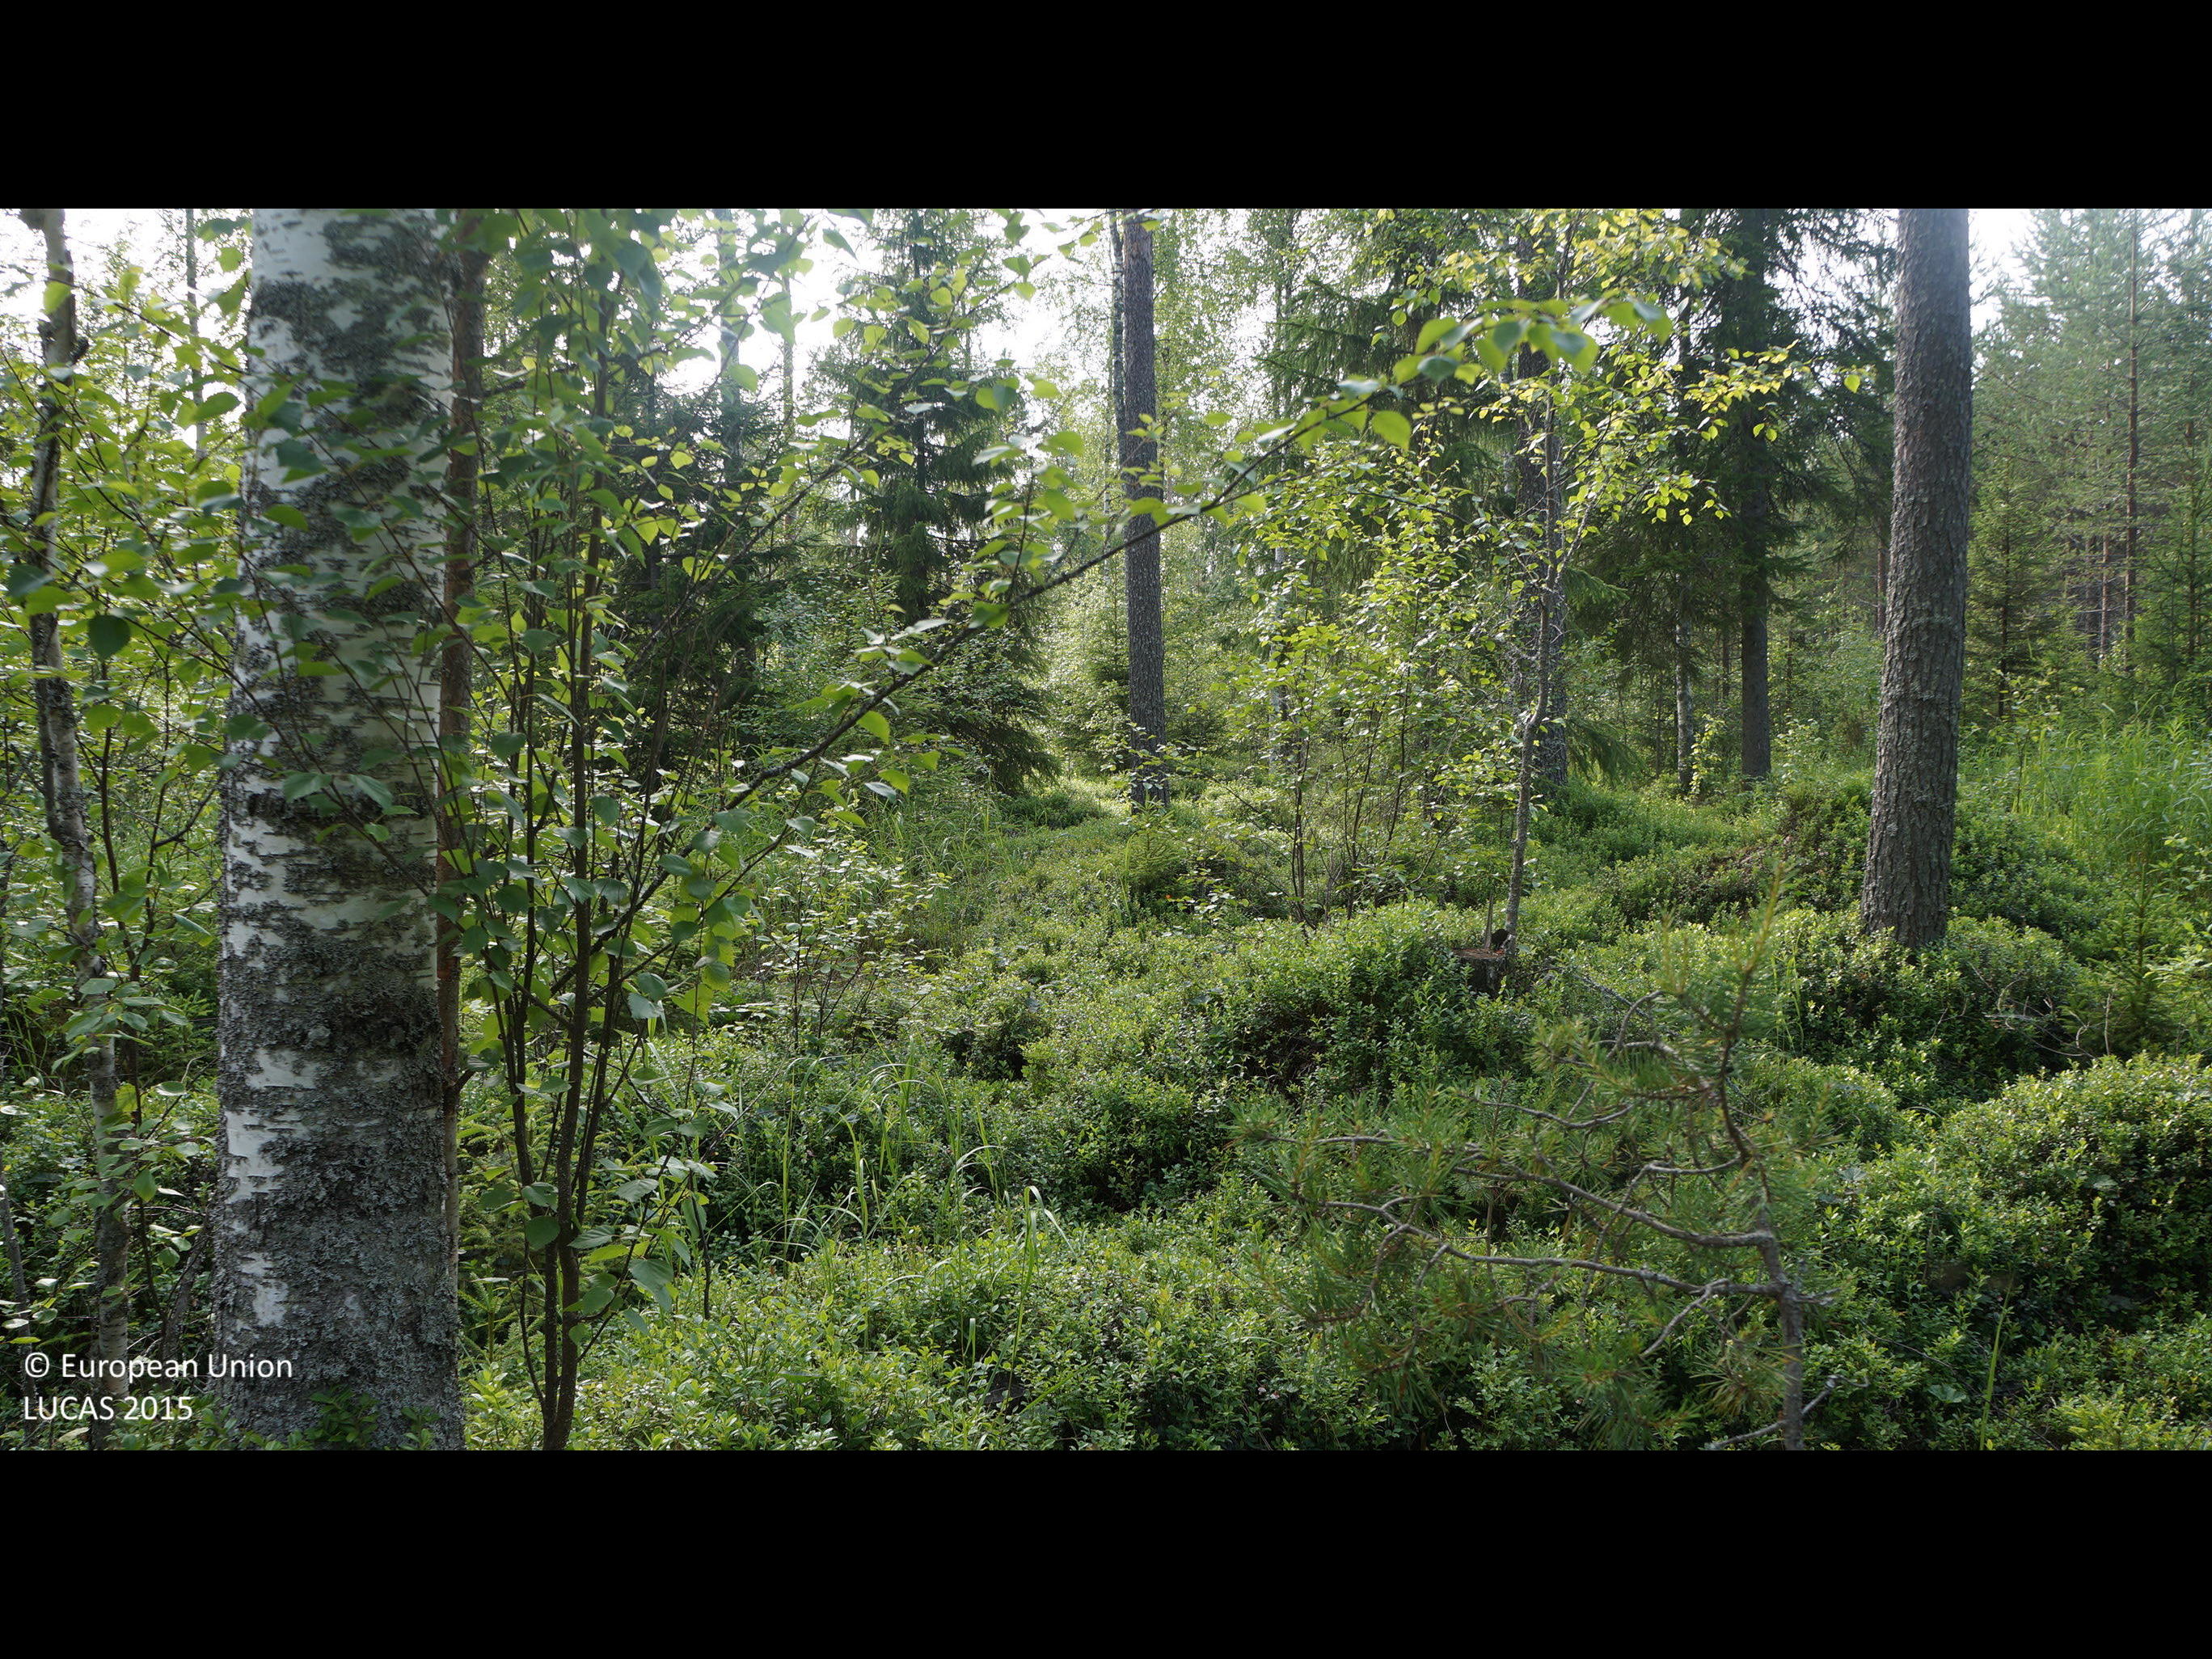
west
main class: Woodland
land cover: Other mixed woodland
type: boreal forest
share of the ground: 50 - 75 %
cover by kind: shrubs 40 %, coniferous forest trees 35 %, broadleaved forest trees 15 %, herbaceous plants 5 %, lichens and mosses 5 %
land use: Forestry
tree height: > 5 m
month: July
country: FI
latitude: 64.6702
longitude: 24.6718
